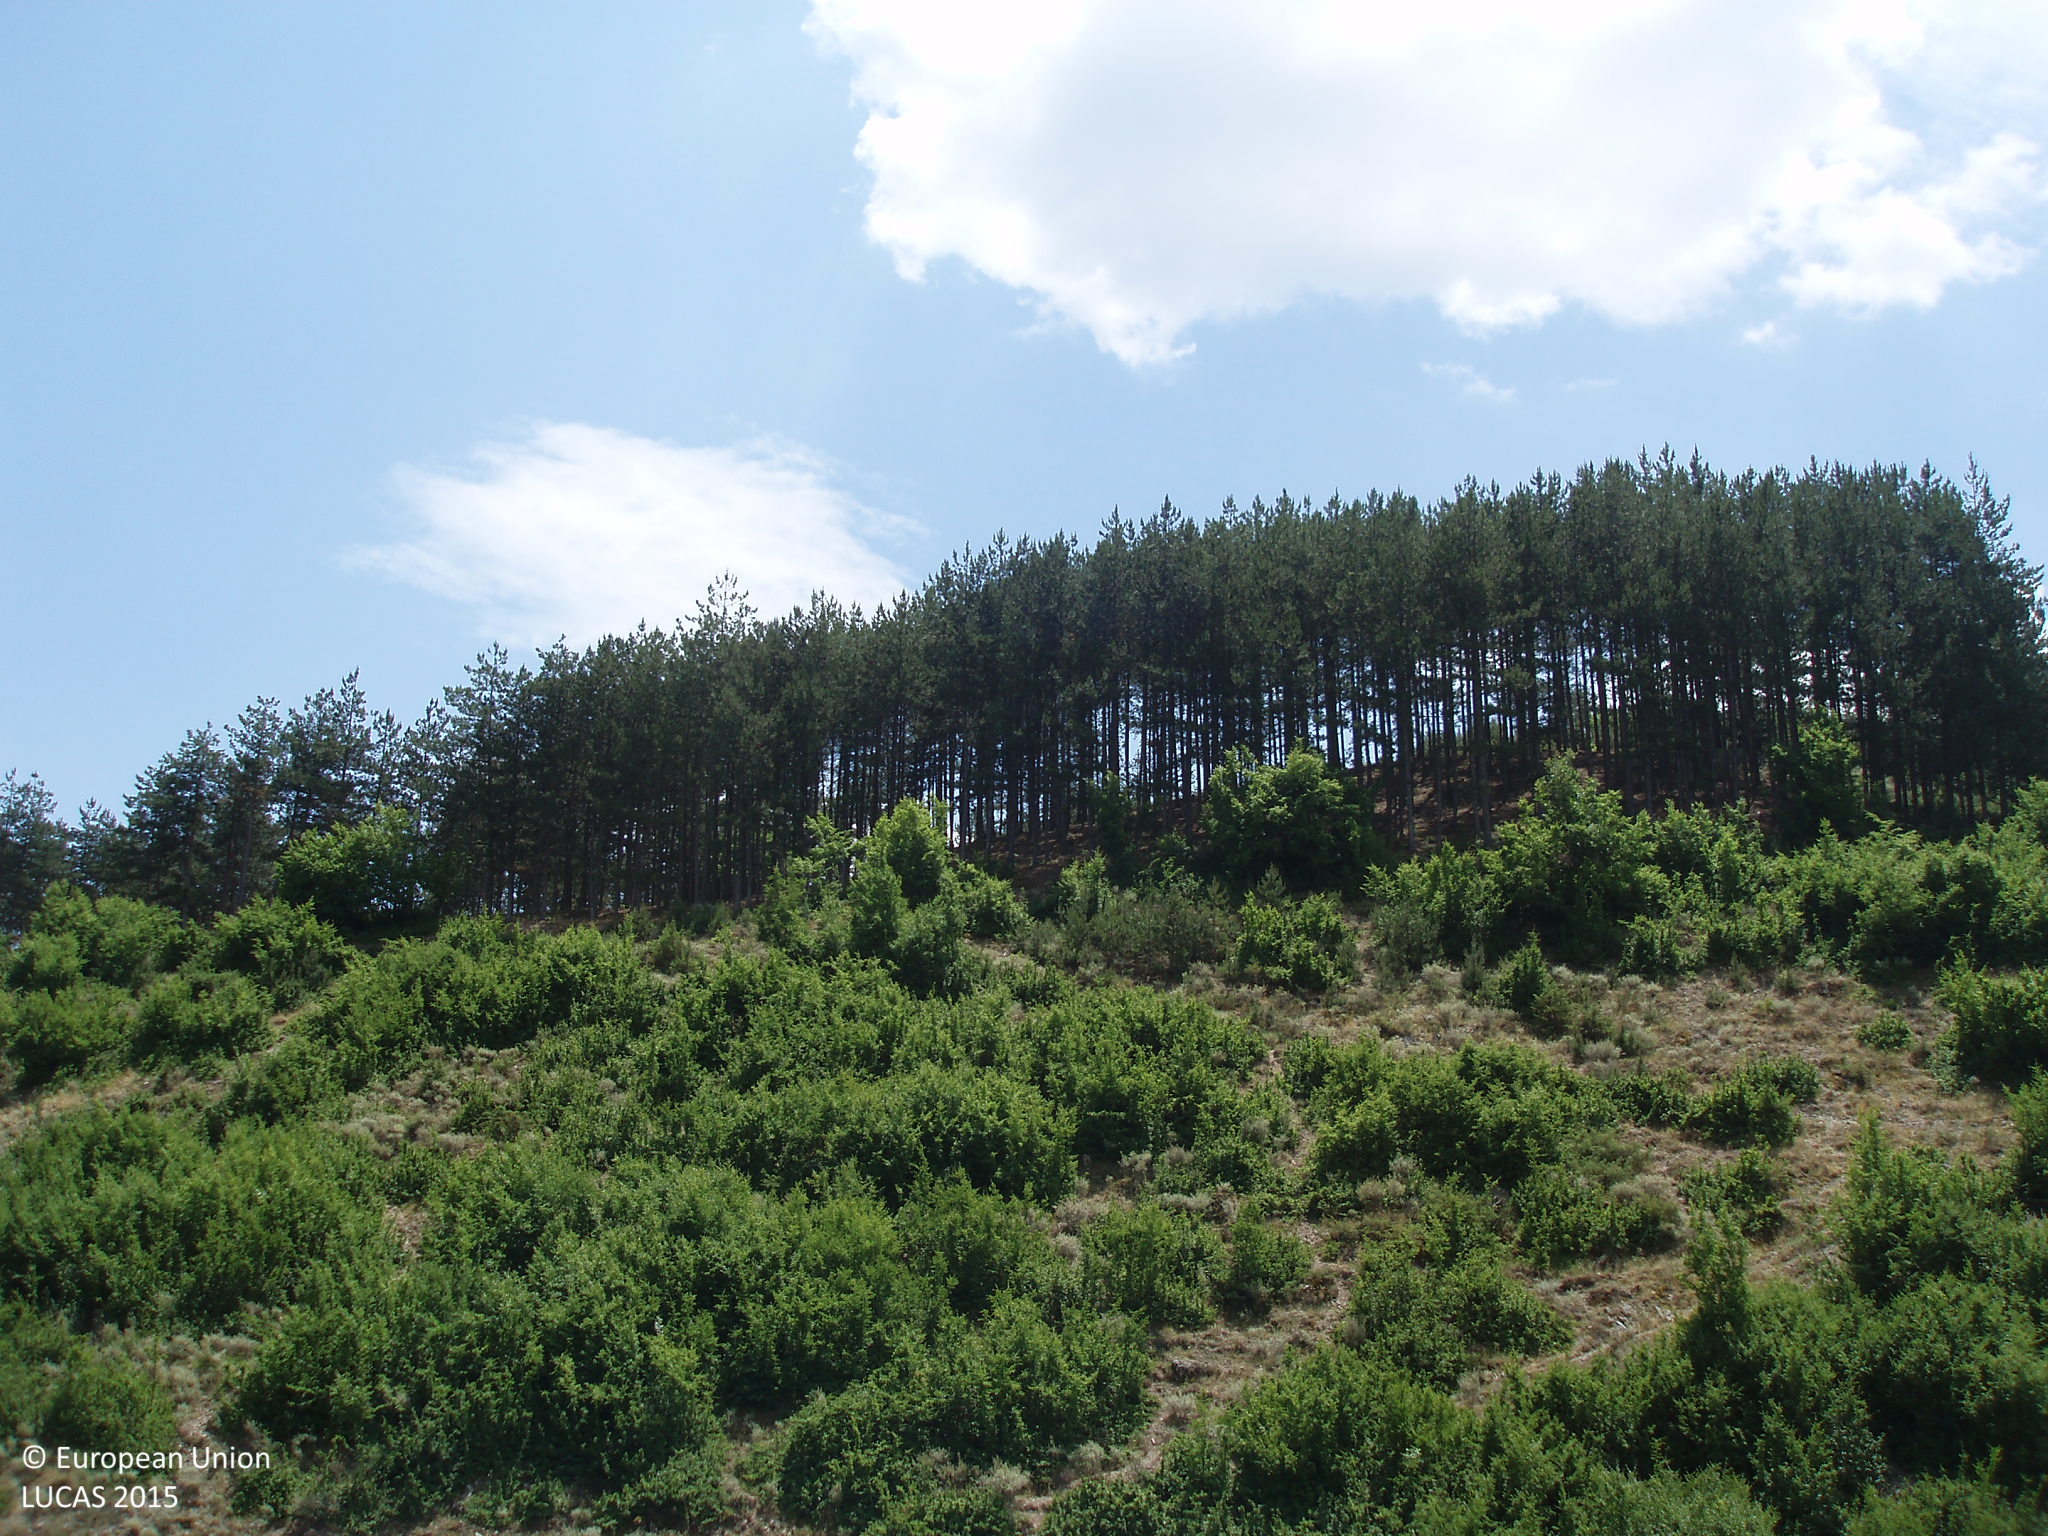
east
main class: Grassland
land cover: Grassland with sparse tree/shrub cover
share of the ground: > 75 %
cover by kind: herbaceous plants 90 %, broadleaved forest trees 5 %, shrubs 5 %
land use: Agriculture (excluding fallow land and kitchen gardens)
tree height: > 5 m
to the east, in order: Grassland with sparse tree/shrub cover; Broadleaved woodland; Pine dominated coniferous woodland; Shrubland with sparse tree cover; Pine dominated coniferous woodland
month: June
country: BG
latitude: 41.5913
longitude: 23.6917
